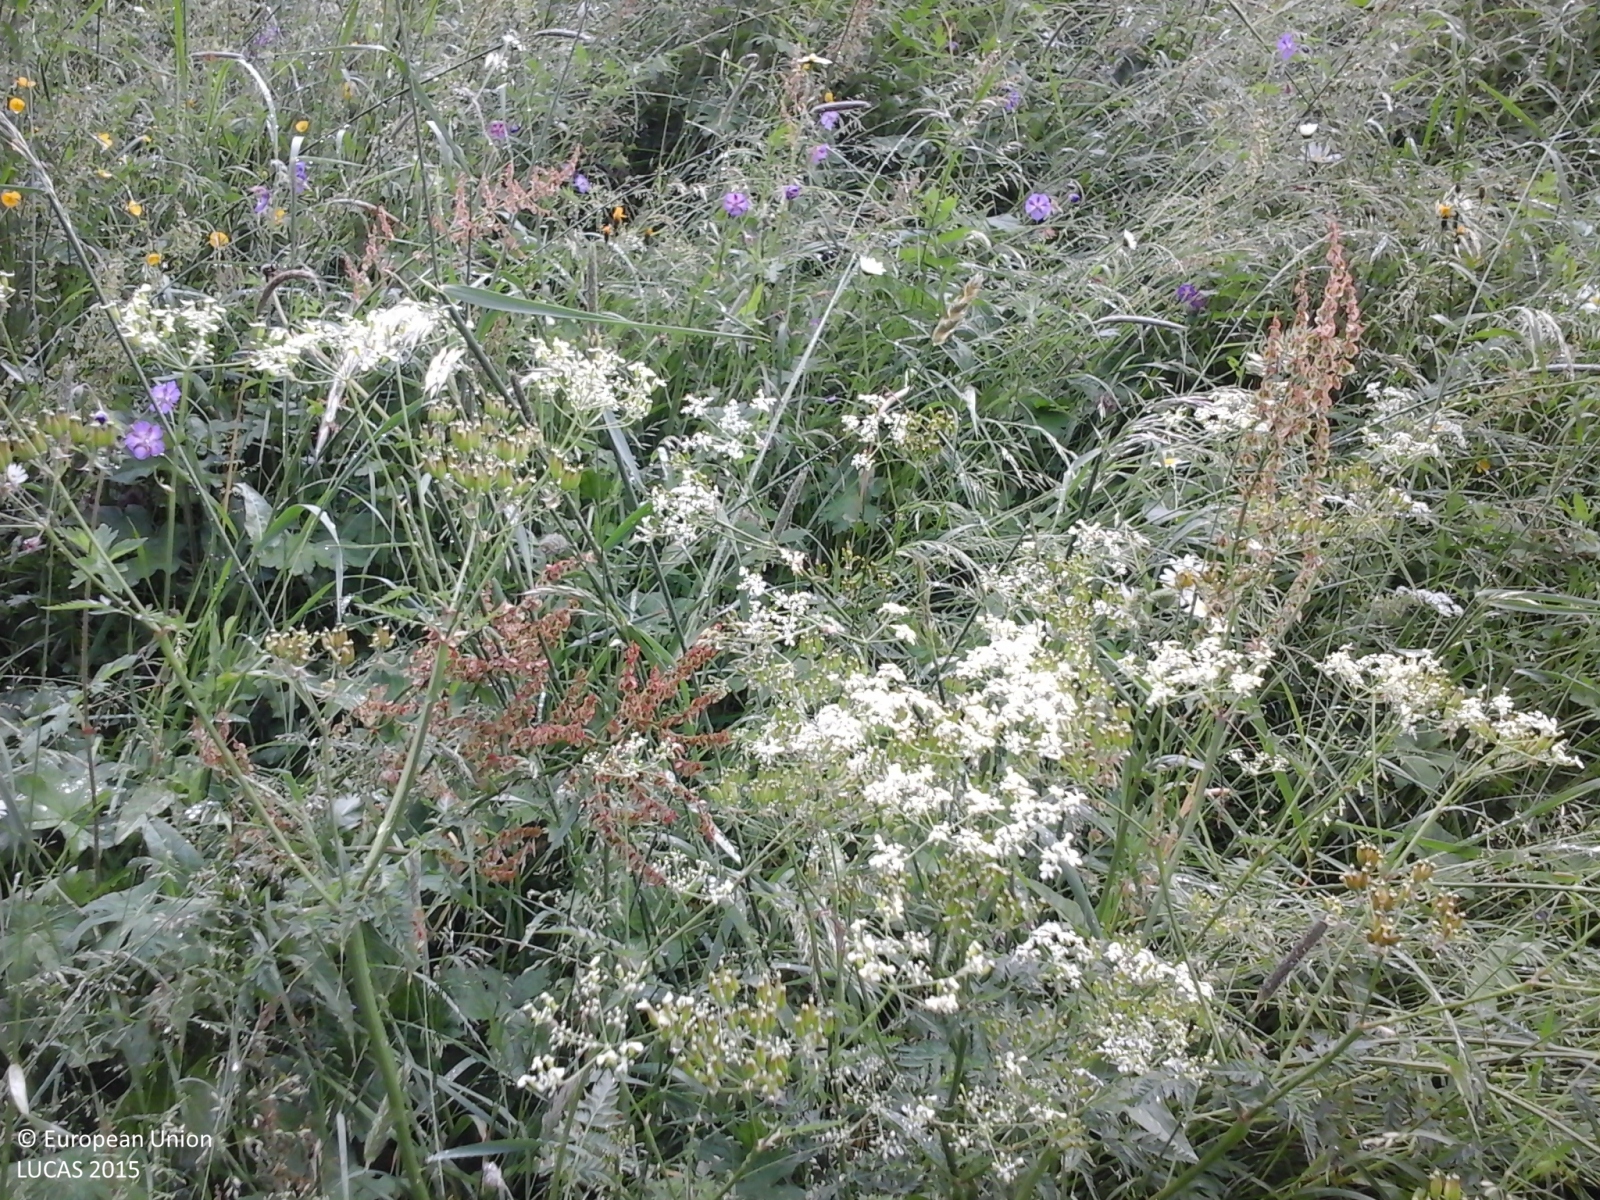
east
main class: Grassland
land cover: Grassland without tree/shrub cover
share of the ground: > 75 %
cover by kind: herbaceous plants 100 %
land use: Agriculture (excluding fallow land and kitchen gardens)
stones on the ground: < 10 %
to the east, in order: Grassland without tree/shrub cover; Electric lines; Grassland without tree/shrub cover; Paved roads, cycling and walking lanes; Grass margins; Electric lines; Paved roads, cycling and walking lanes; Conifer hedges; Grassland without tree/shrub cover; Spruce dominated coniferous woodland; Paved roads, cycling and walking lanes; Spruce dominated coniferous woodland; Paved roads, cycling and walking lanes; Spruce dominated coniferous woodland
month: June
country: IT
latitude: 46.9537
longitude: 11.4570
